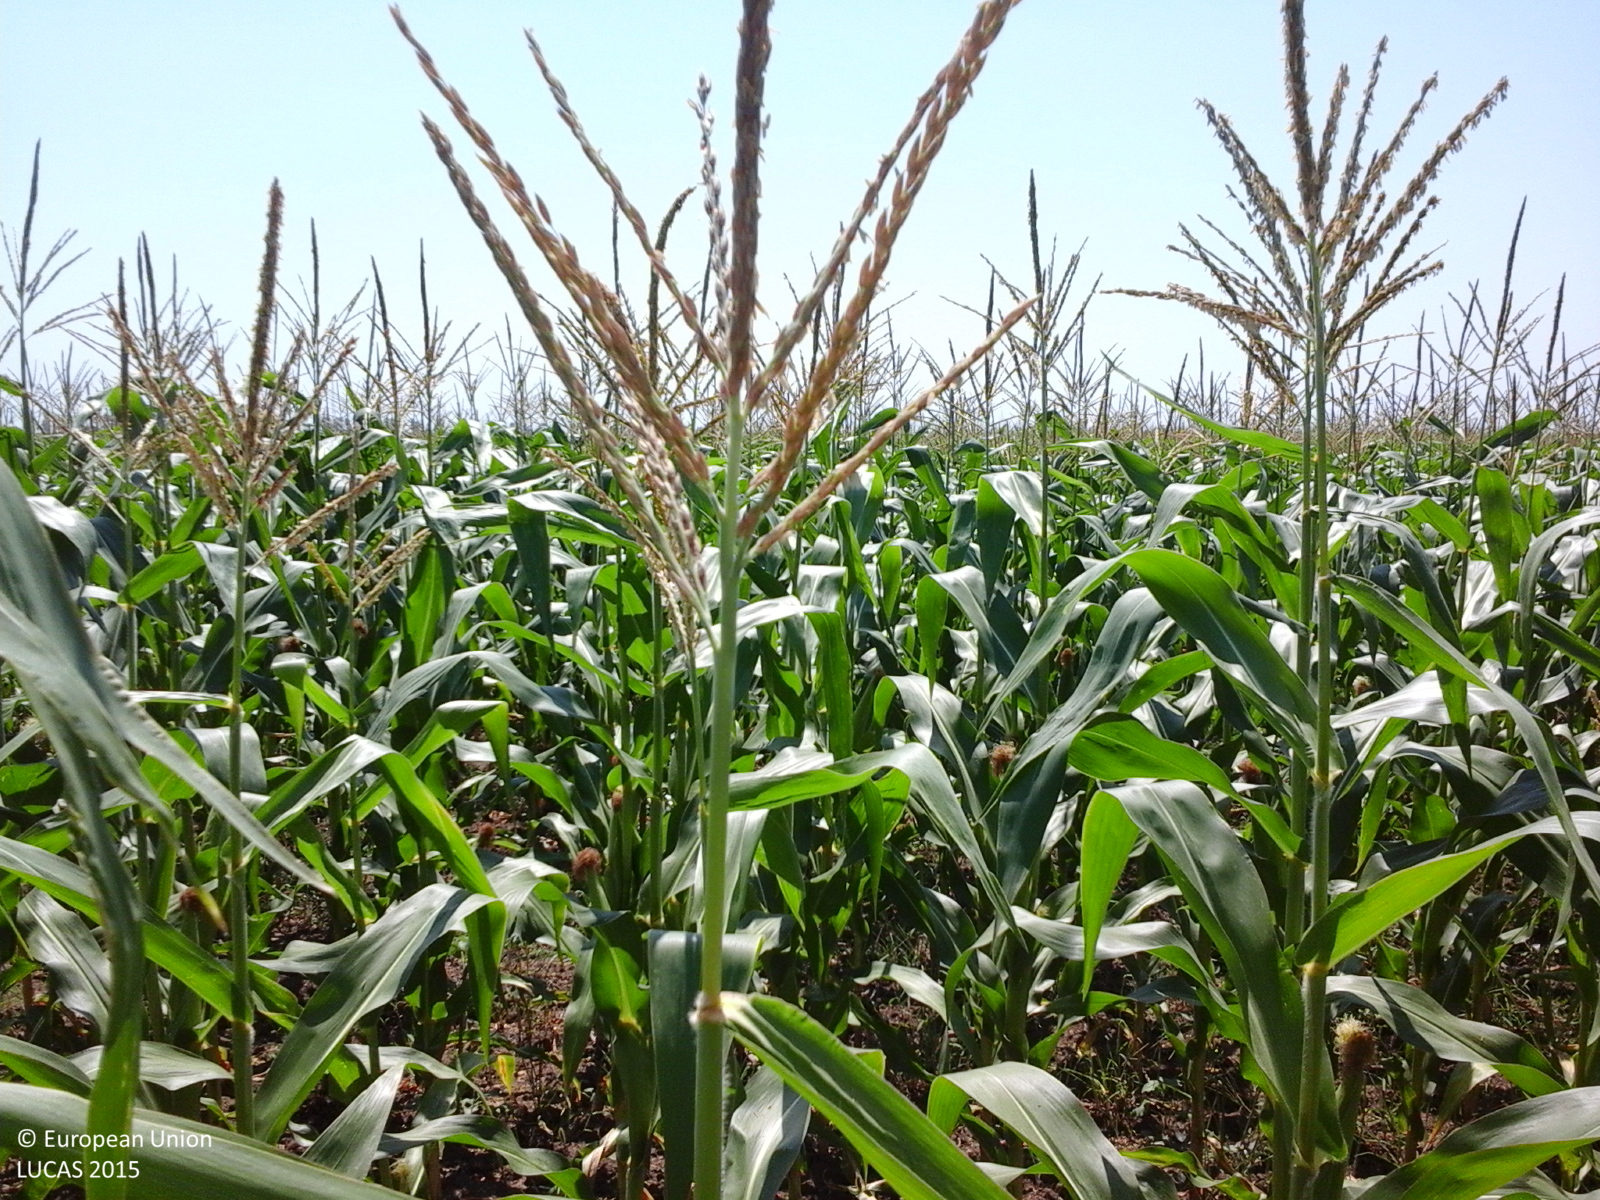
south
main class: Cropland
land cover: Maize
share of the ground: > 75 %
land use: Agriculture (excluding fallow land and kitchen gardens)
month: July
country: RO
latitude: 44.9261
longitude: 27.3094
